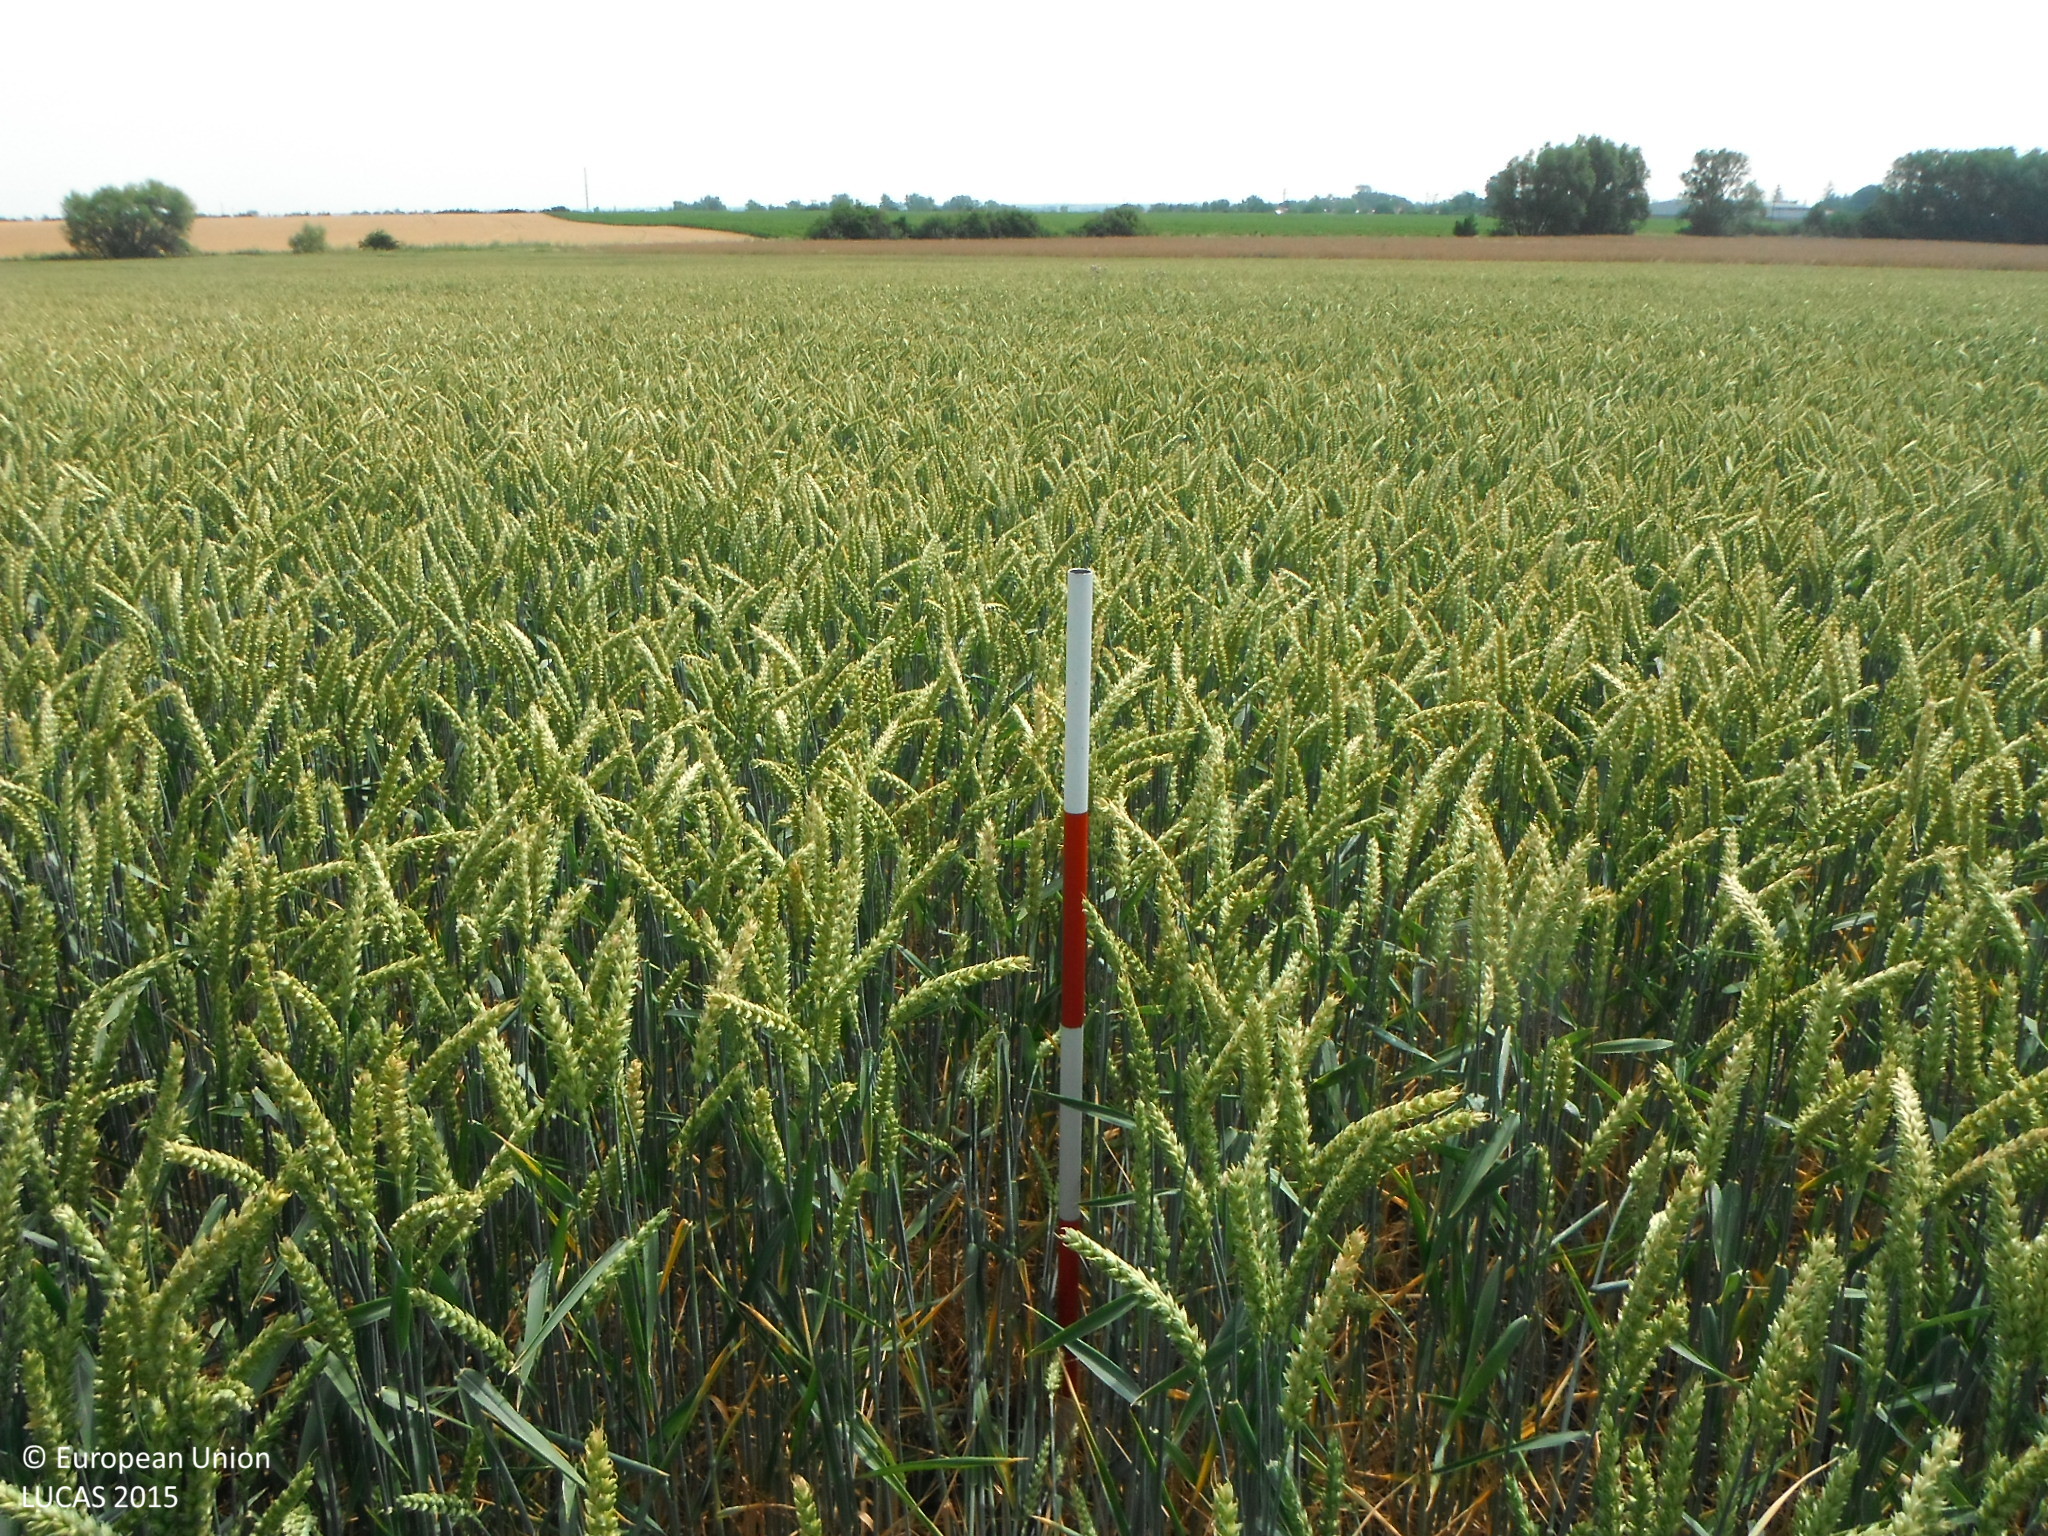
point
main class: Cropland
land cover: Common wheat
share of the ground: > 75 %
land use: Agriculture (excluding fallow land and kitchen gardens)
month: June
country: SK
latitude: 48.6393
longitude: 21.6527
